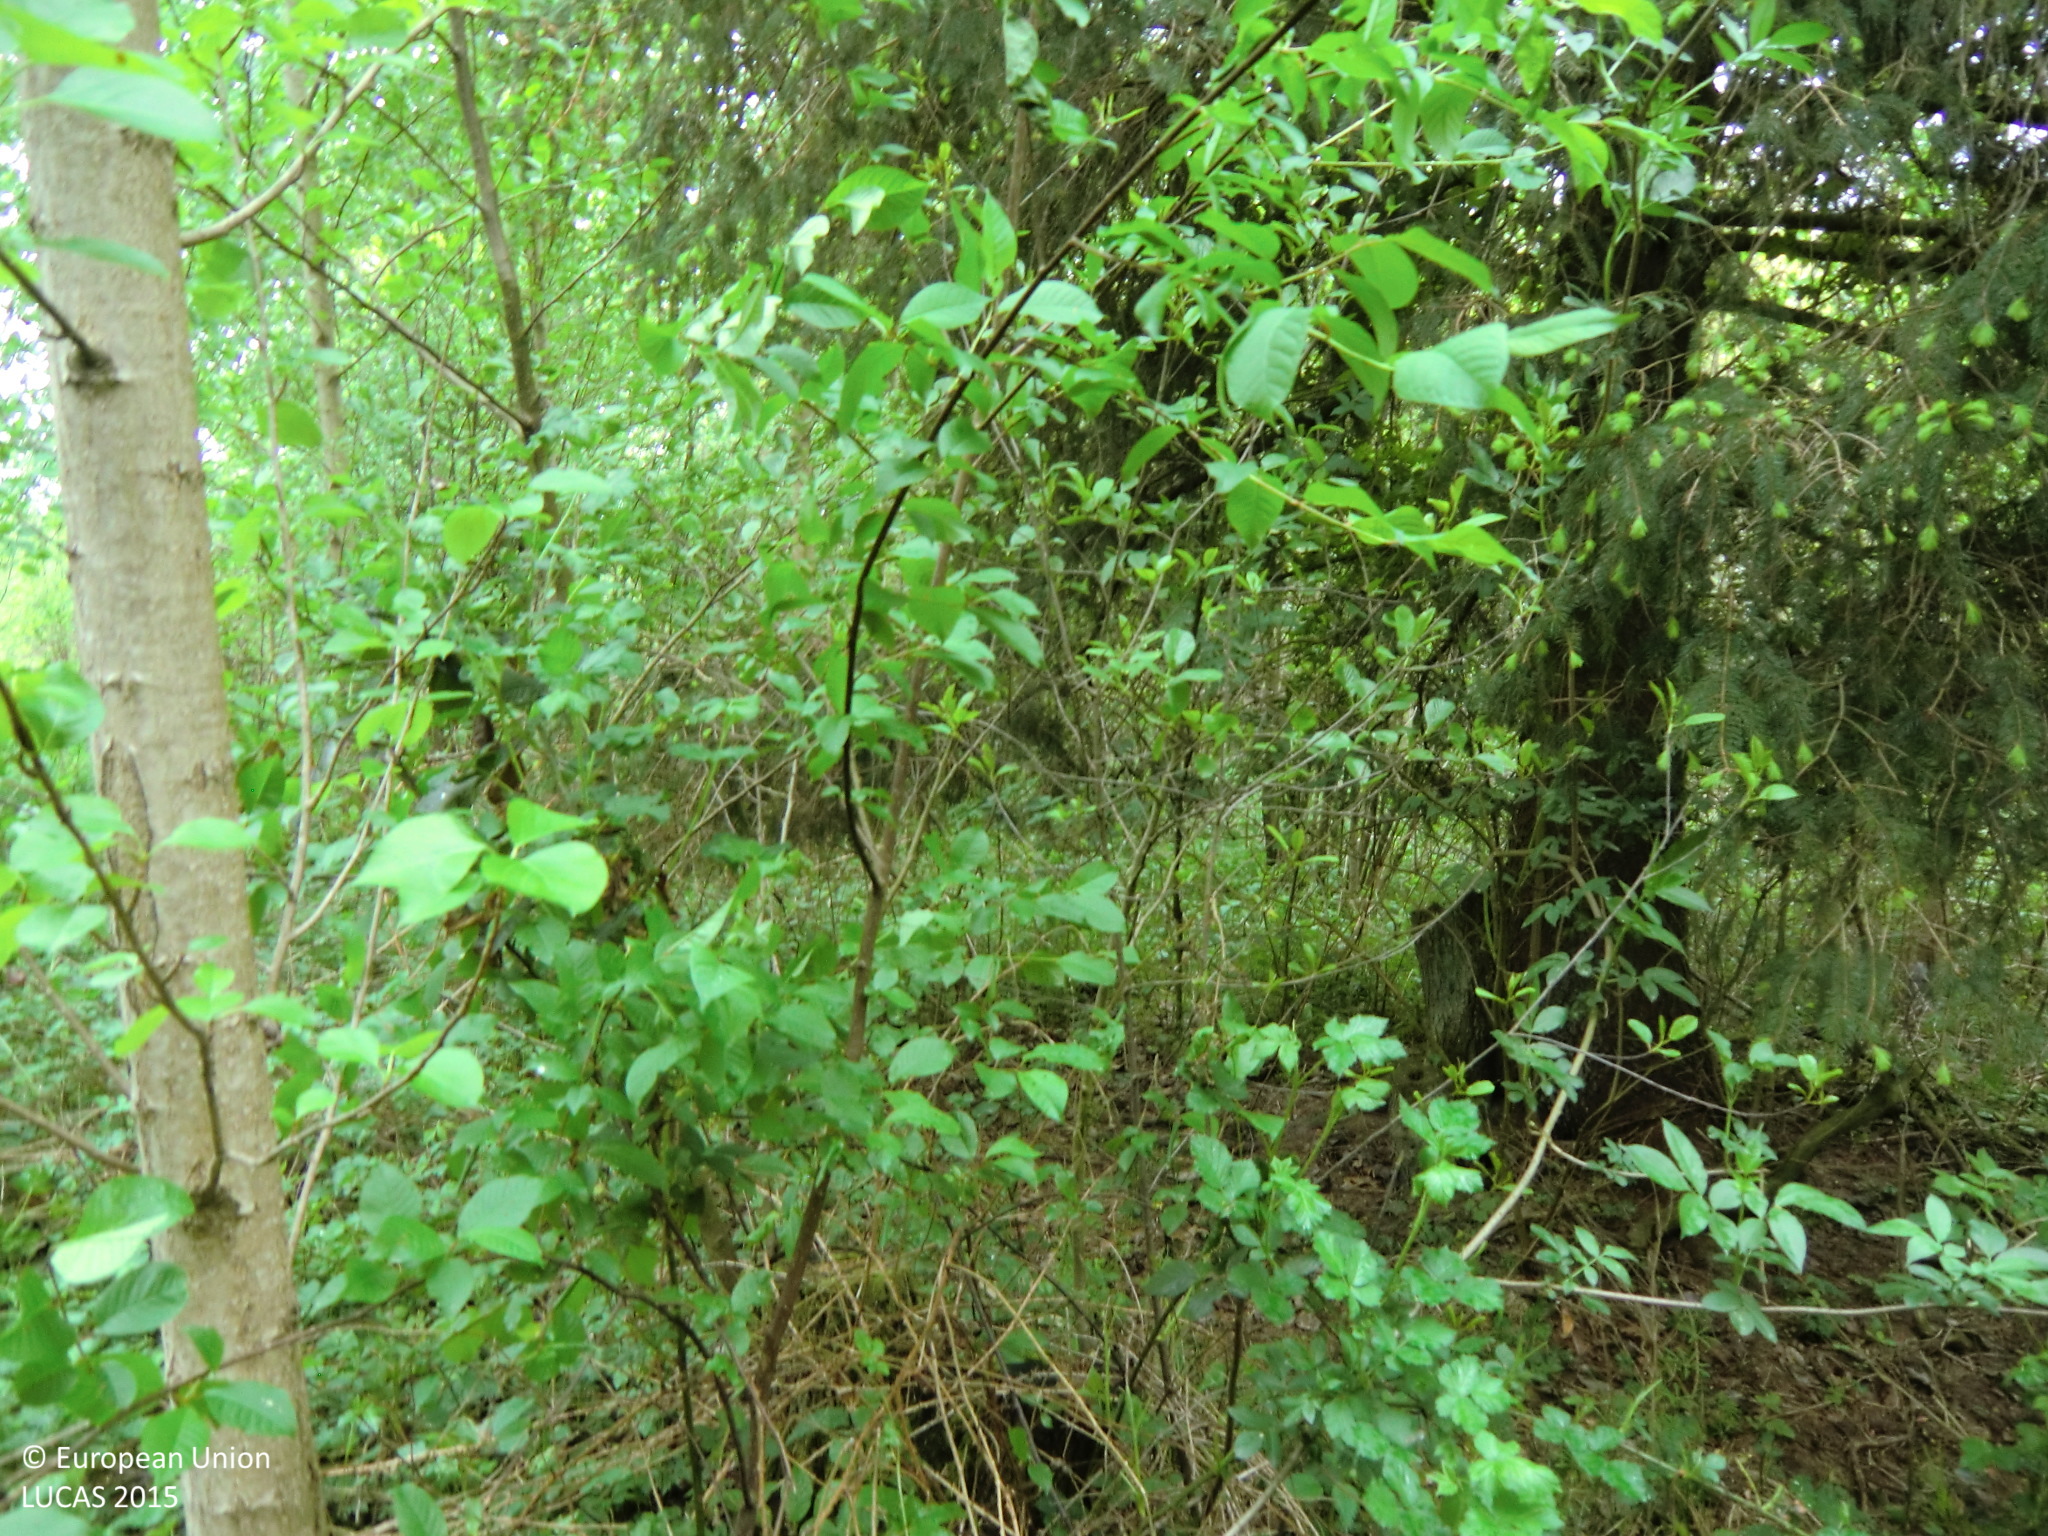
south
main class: Woodland
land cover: Spruce dominated mixed woodland
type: hemiboreal forest and nemoral coniferous forest and mixed broadleaved-coniferous forest
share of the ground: > 75 %
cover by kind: broadleaved forest trees 50 %, coniferous forest trees 30 %, shrubs 20 %
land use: Forestry
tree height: > 5 m
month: May
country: AT
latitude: 48.2136
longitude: 14.6975
